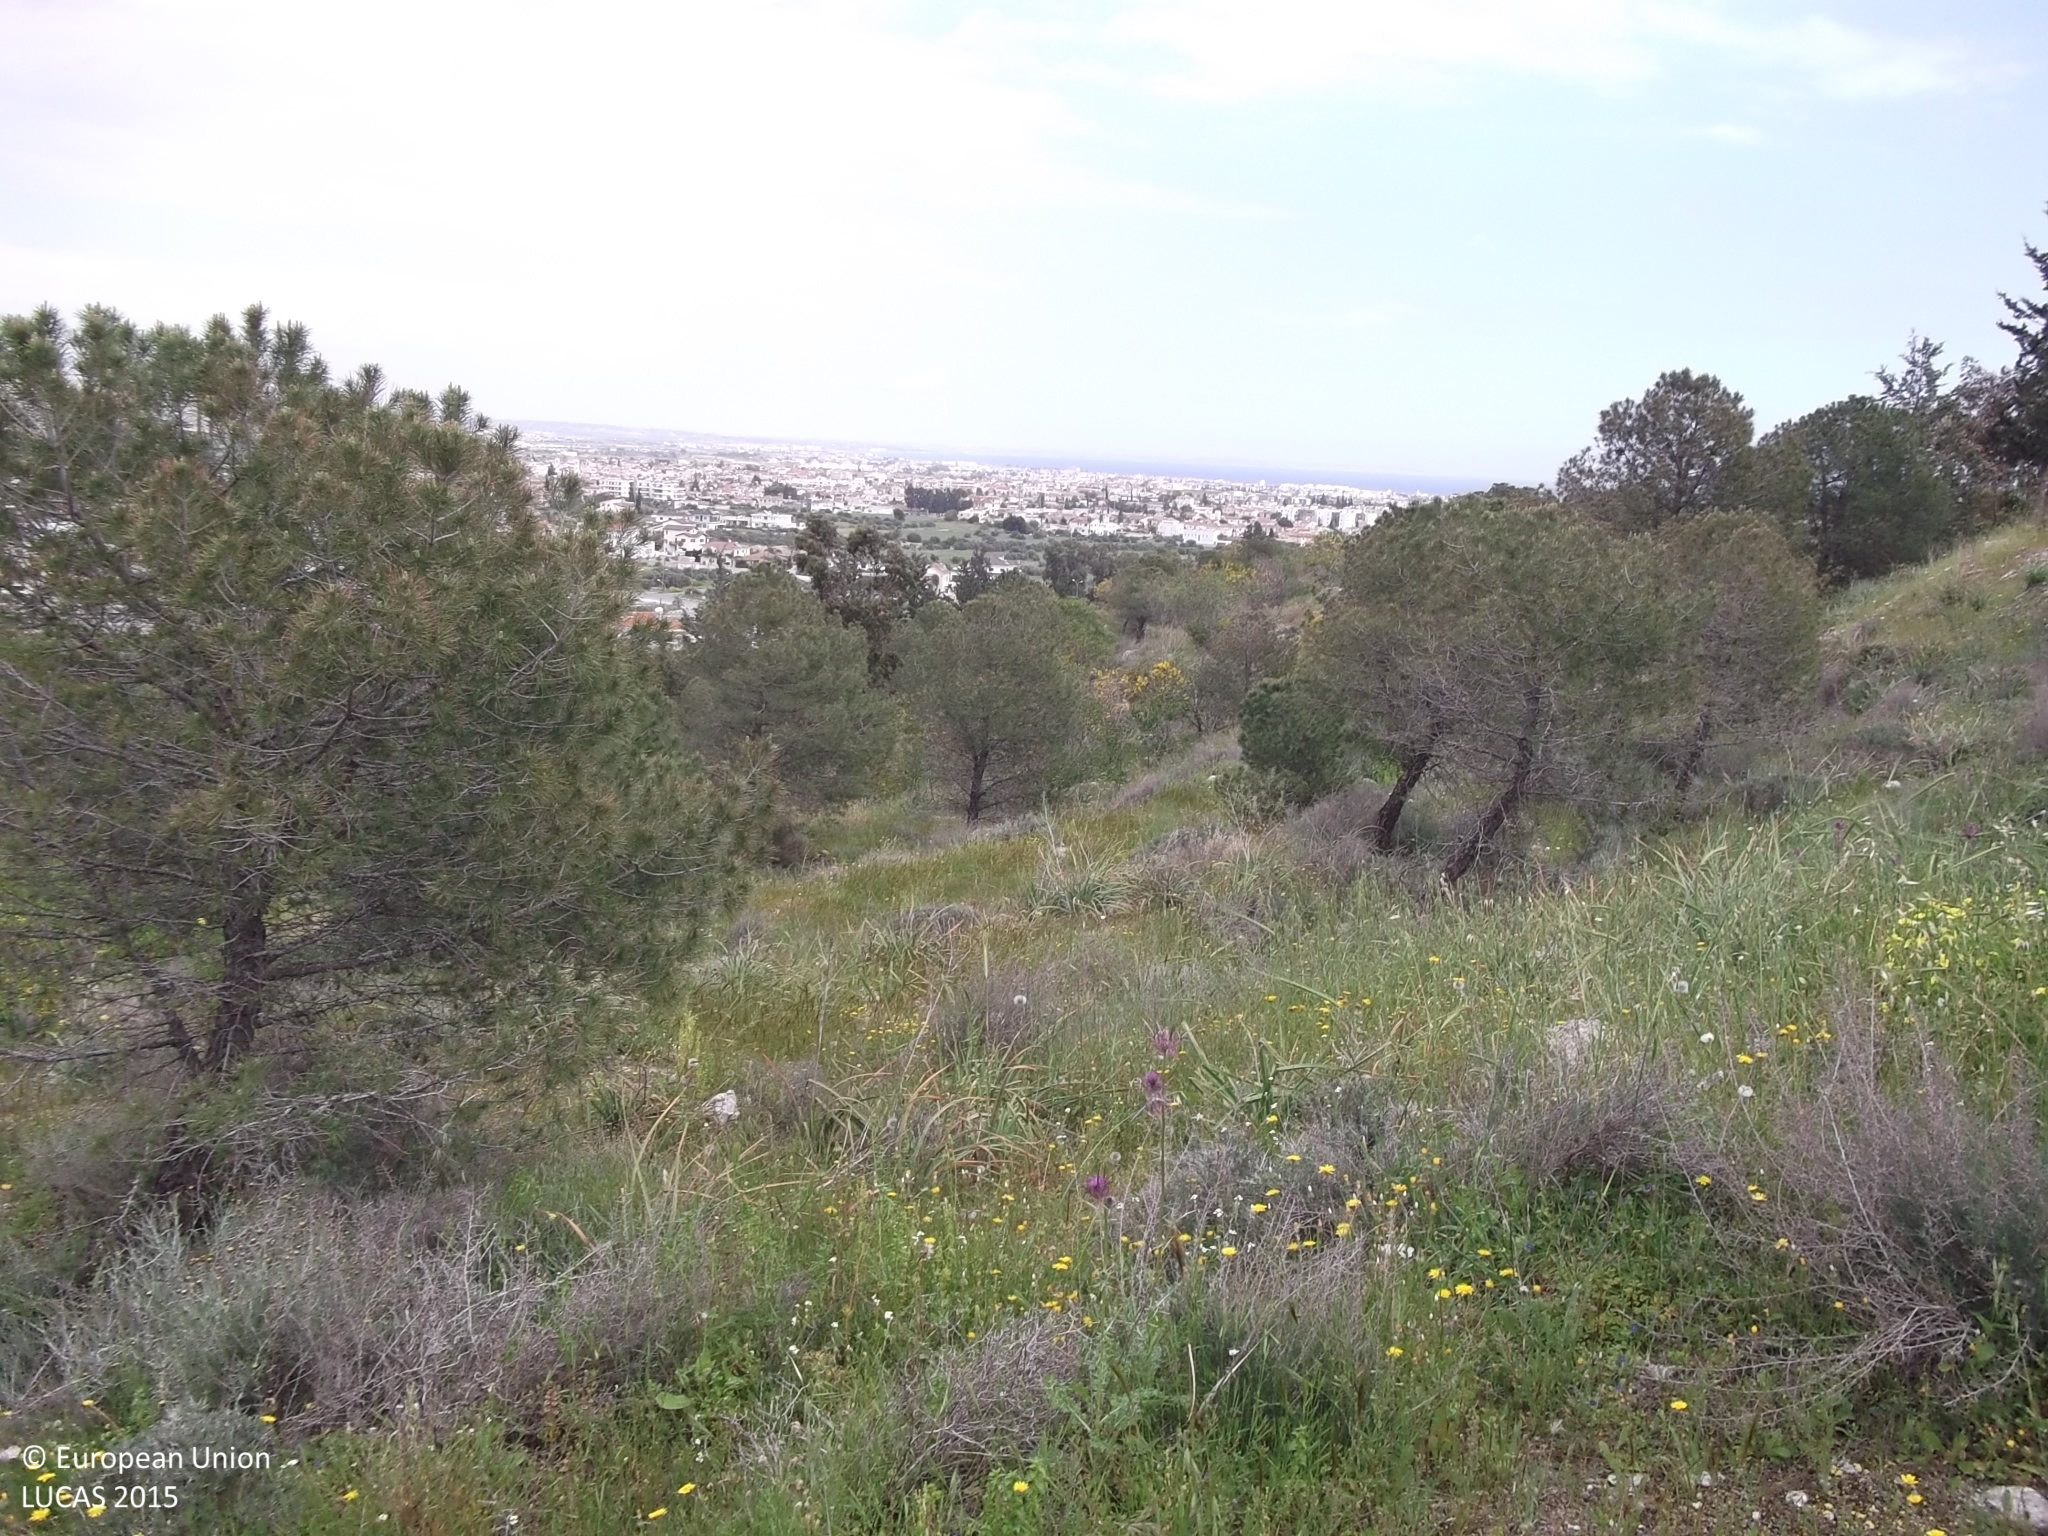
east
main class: Woodland
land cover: Pine dominated coniferous woodland
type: coniferous forest of the mediterranean region
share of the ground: 25 - 50 %
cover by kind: herbaceous plants 50 %, coniferous forest trees 30 %, shrubs 20 %
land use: Semi-natural and natural areas not in use
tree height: > 5 m
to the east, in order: Pine dominated coniferous woodland; Tracks; Pine dominated mixed woodland; Tracks; Broadleaved woodland
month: April
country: CY
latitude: 34.9460
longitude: 33.5724
